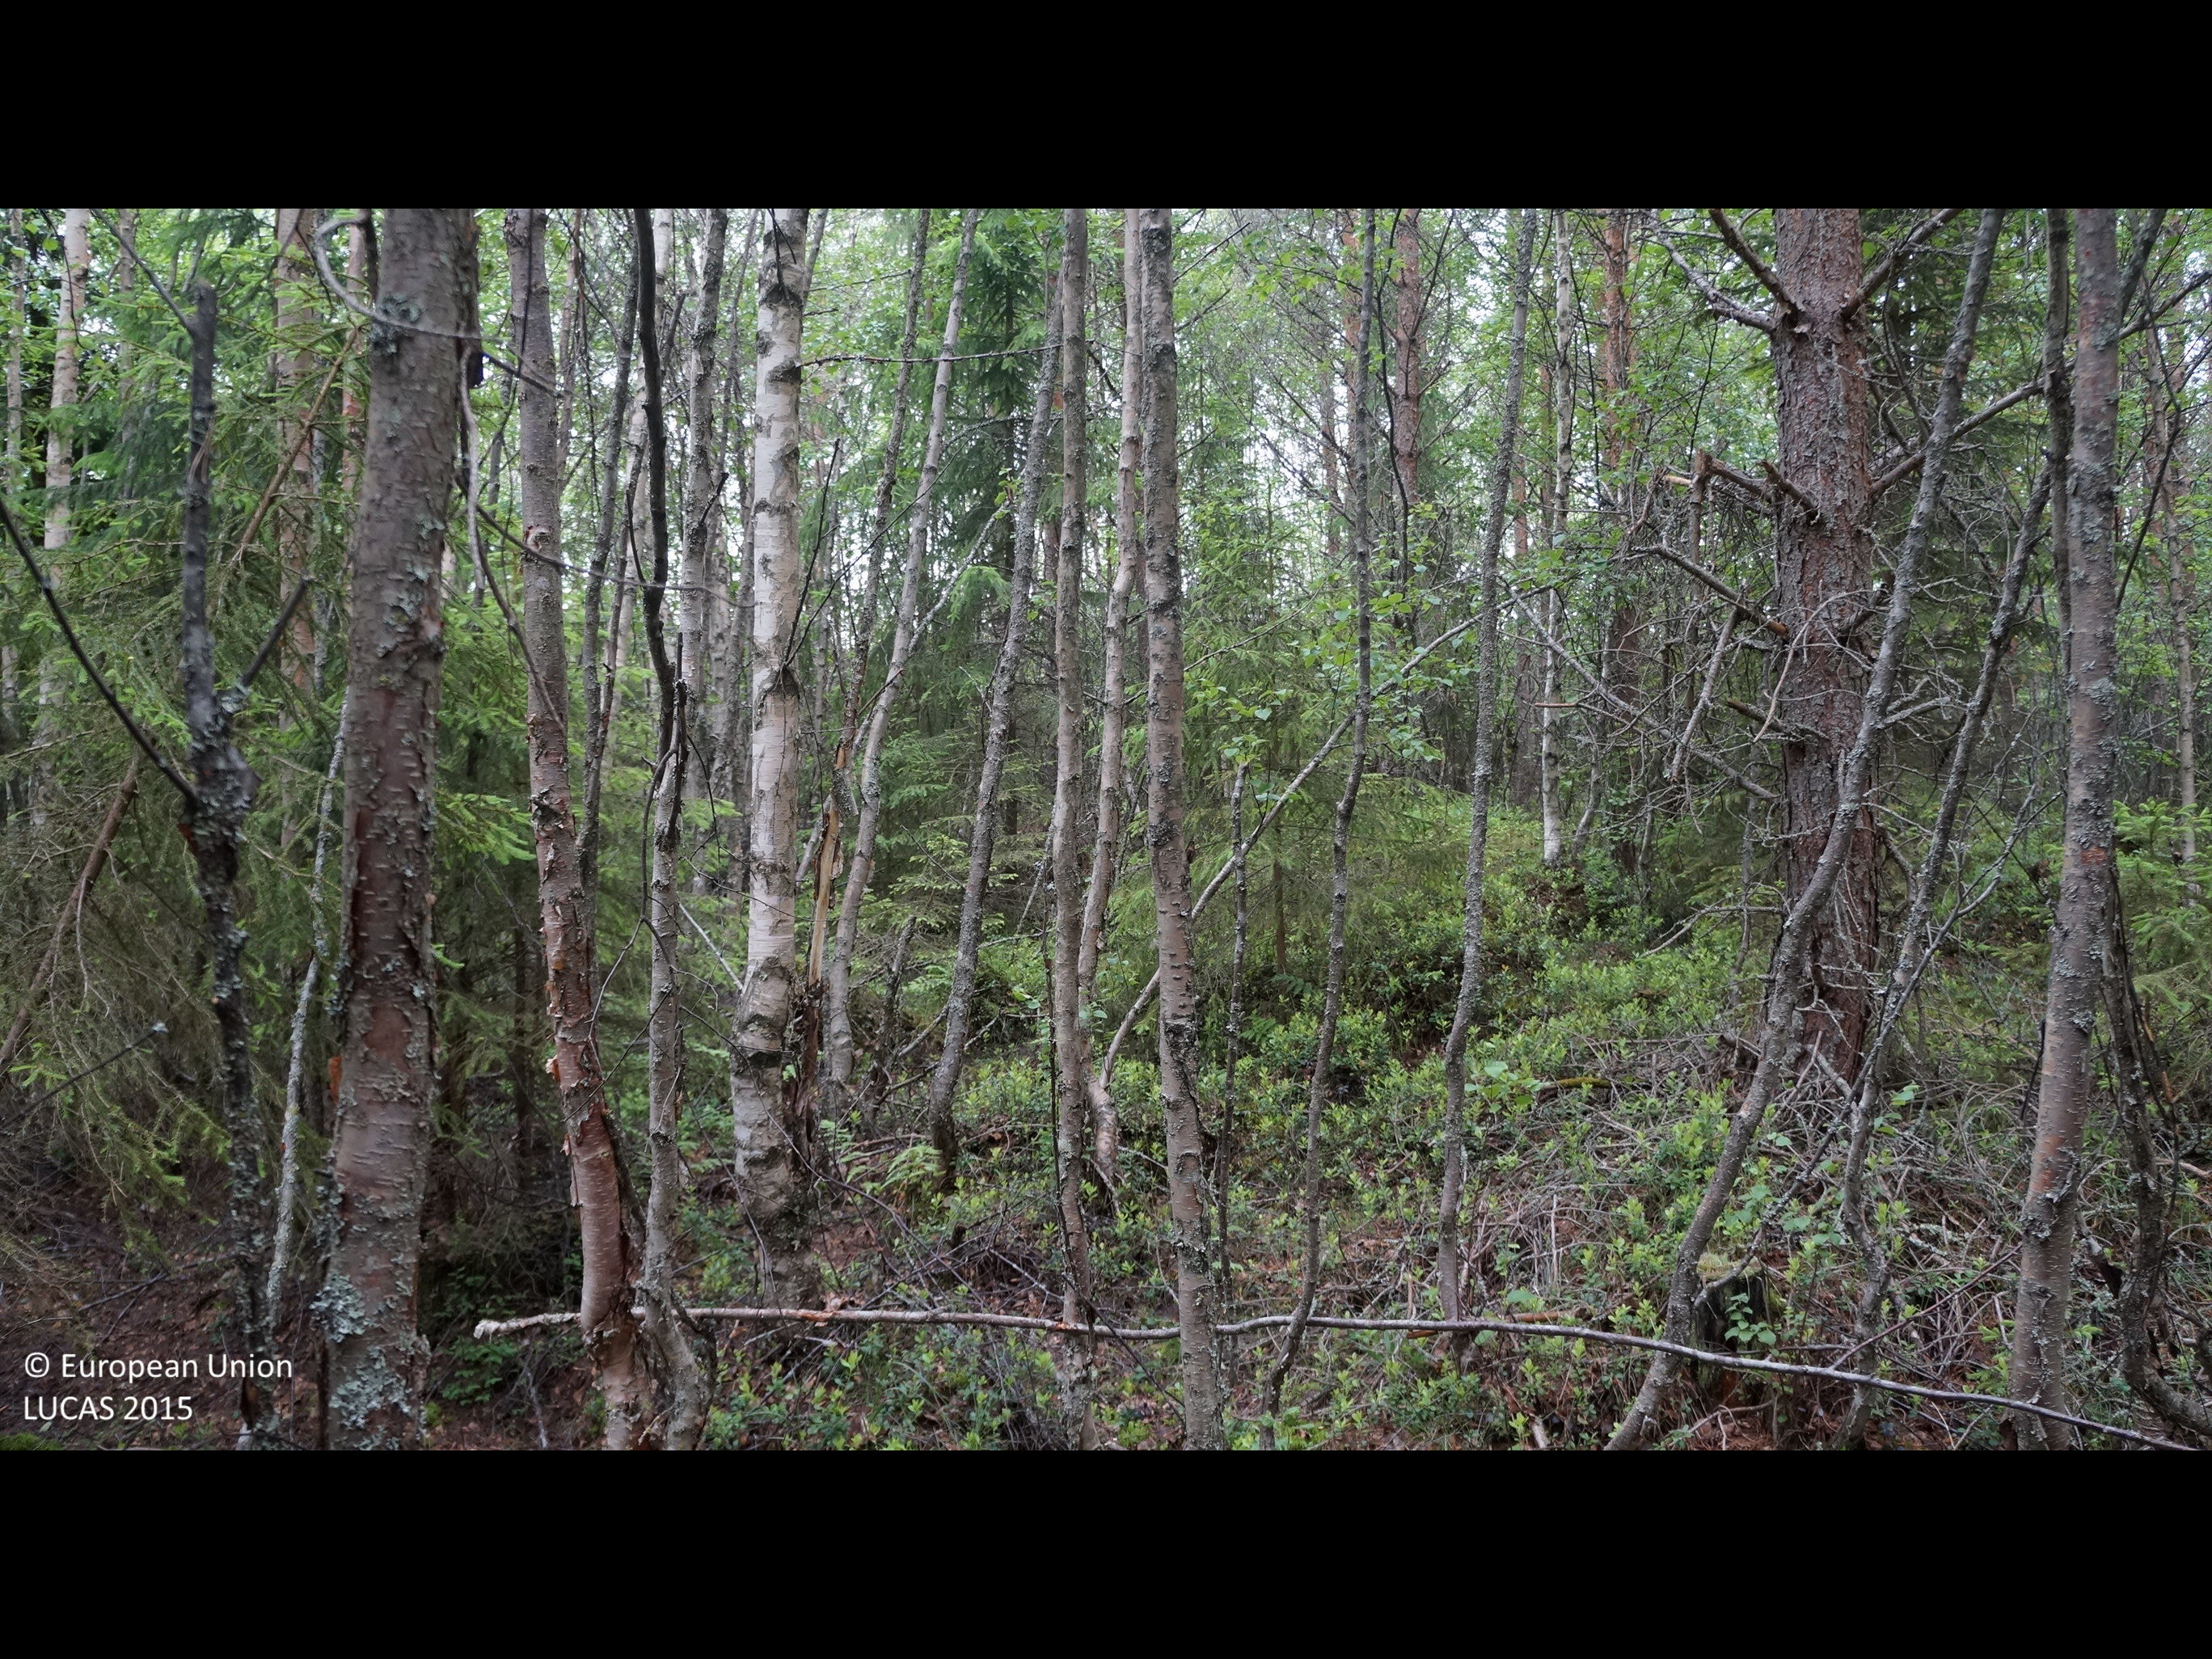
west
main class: Woodland
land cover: Other mixed woodland
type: boreal forest
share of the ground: > 75 %
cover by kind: coniferous forest trees 40 %, broadleaved forest trees 35 %, shrubs 20 %, lichens and mosses 5 %
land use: Forestry
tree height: > 5 m
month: June
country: FI
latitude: 63.8927
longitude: 23.2733
